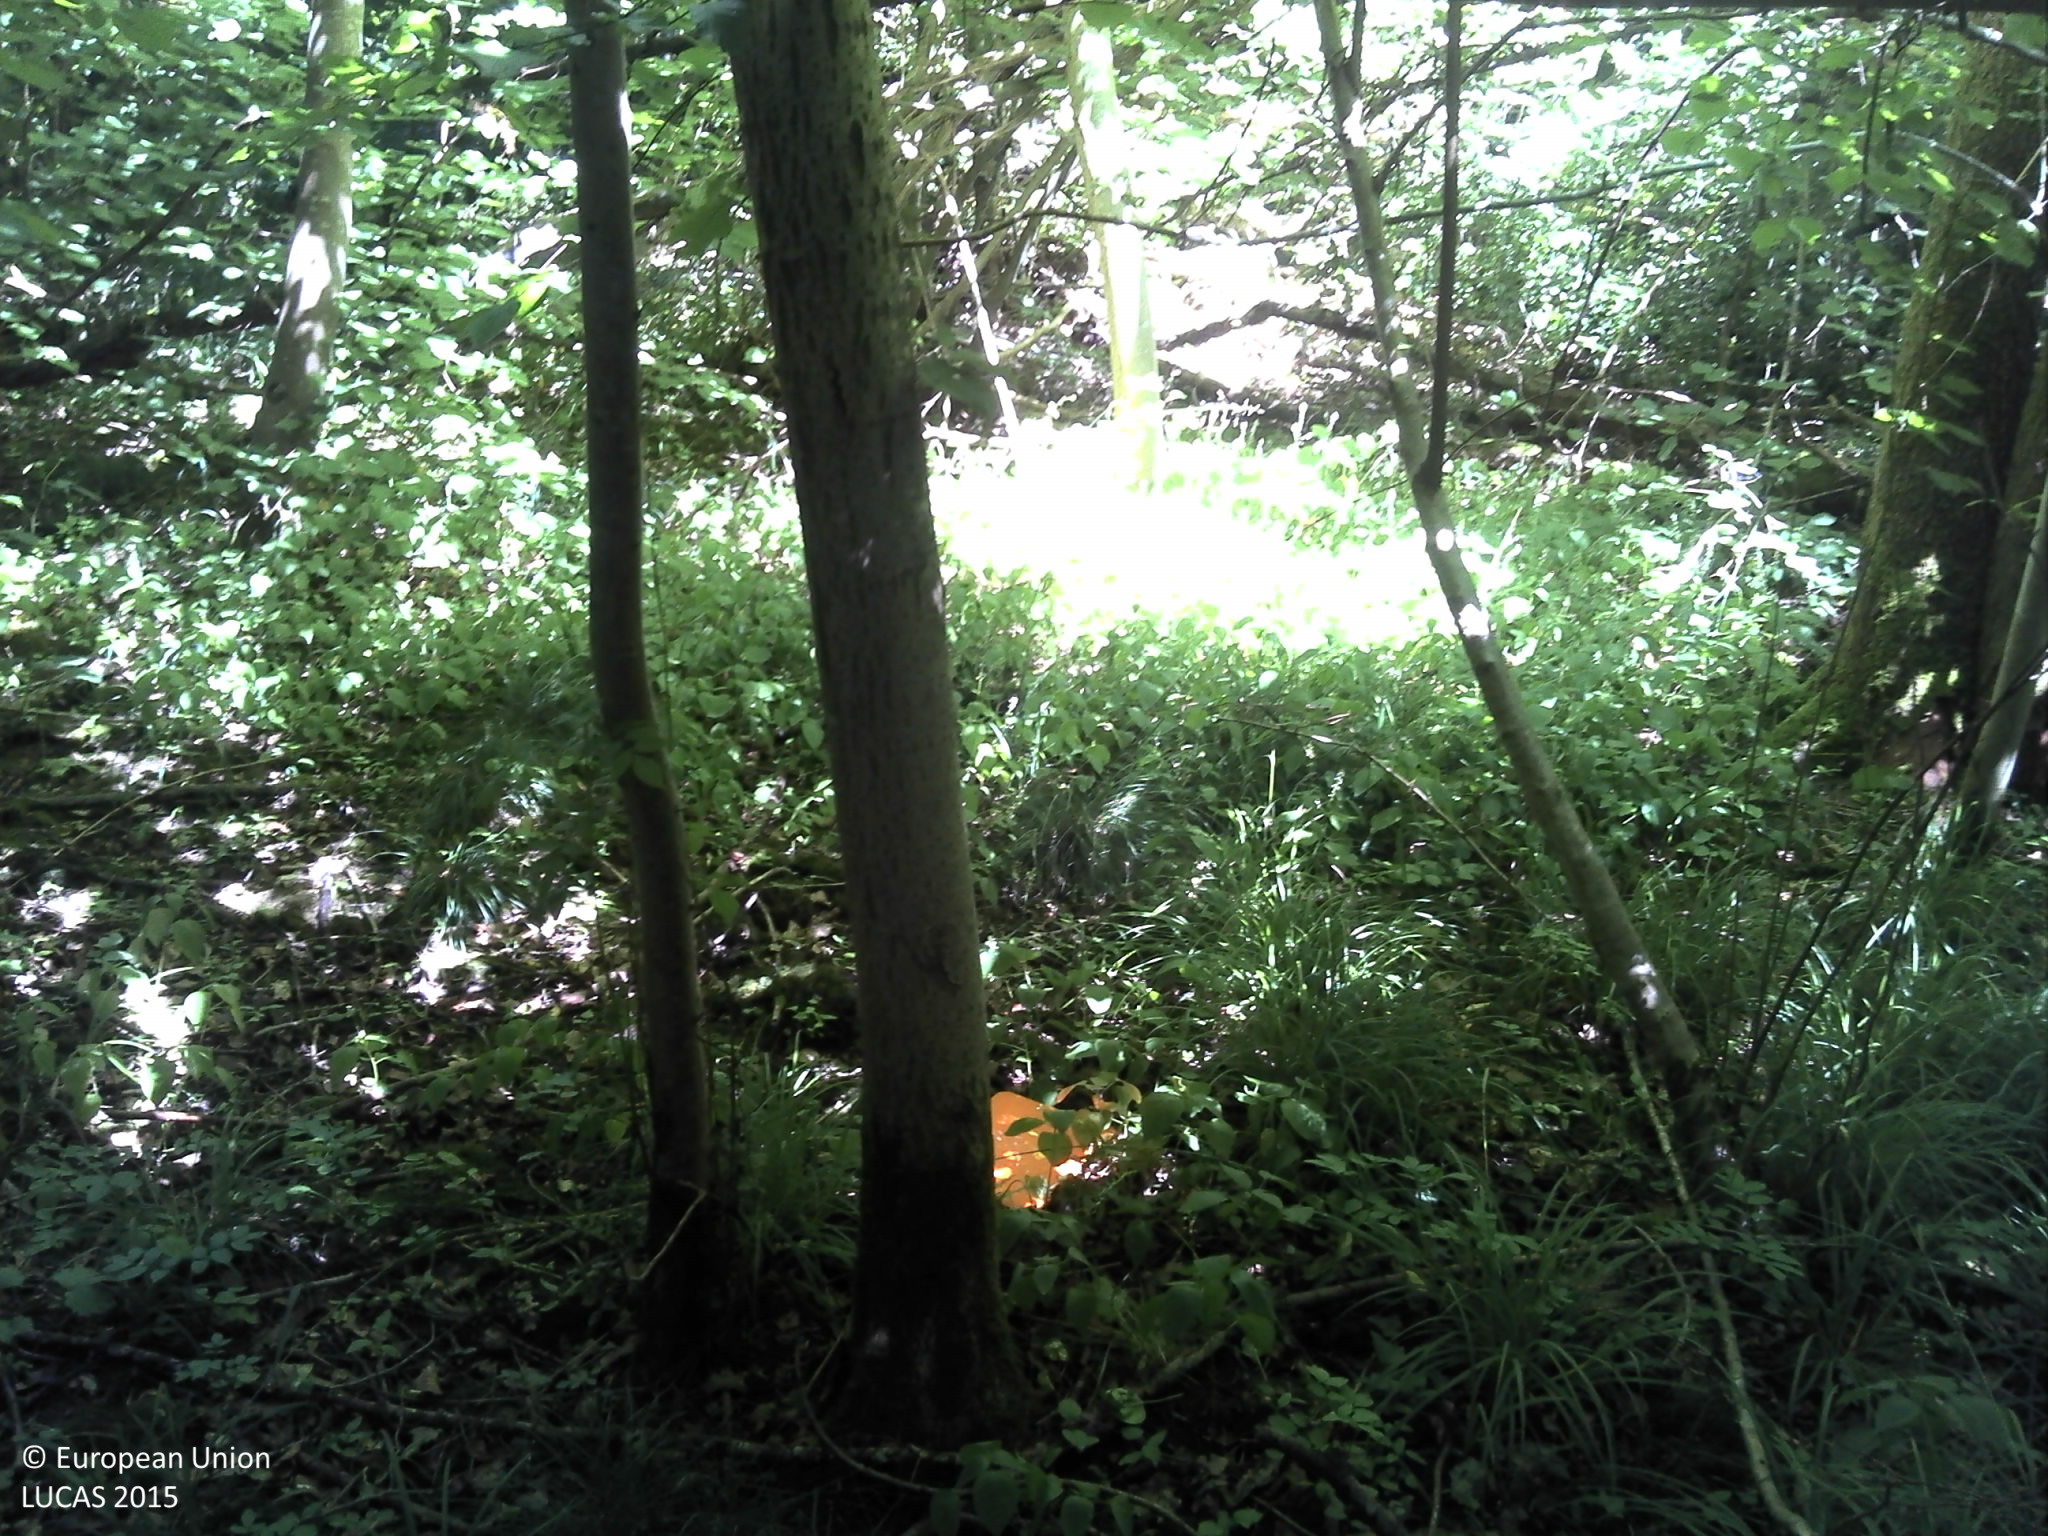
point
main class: Woodland
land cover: Broadleaved woodland
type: beech forest
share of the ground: > 75 %
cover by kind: broadleaved forest trees 60 %, herbaceous plants 30 %, lichens and mosses 5 %, consolidated bare surface 5 %
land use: Forestry
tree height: > 5 m
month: July
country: FR
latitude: 49.5386
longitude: 4.7042
